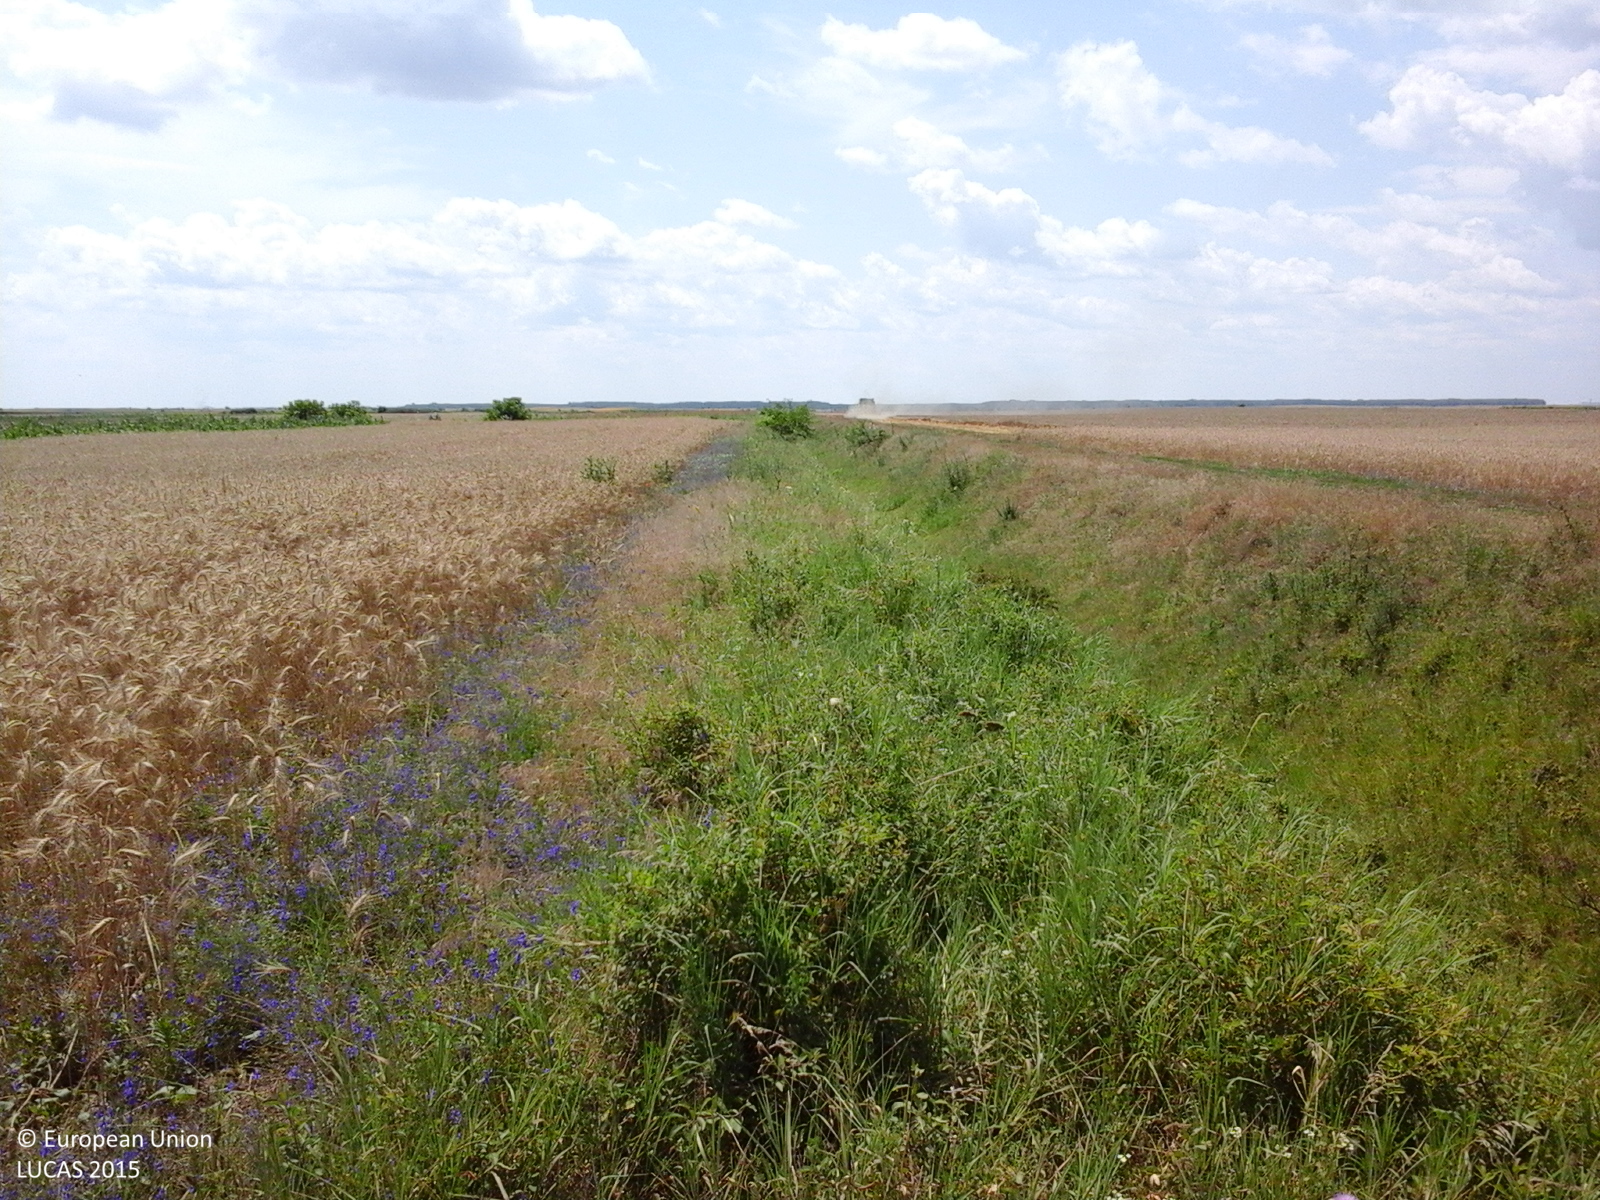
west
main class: Cropland
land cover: Common wheat
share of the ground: > 75 %
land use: Agriculture (excluding fallow land and kitchen gardens)
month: July
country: RO
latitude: 43.9577
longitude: 24.5606
